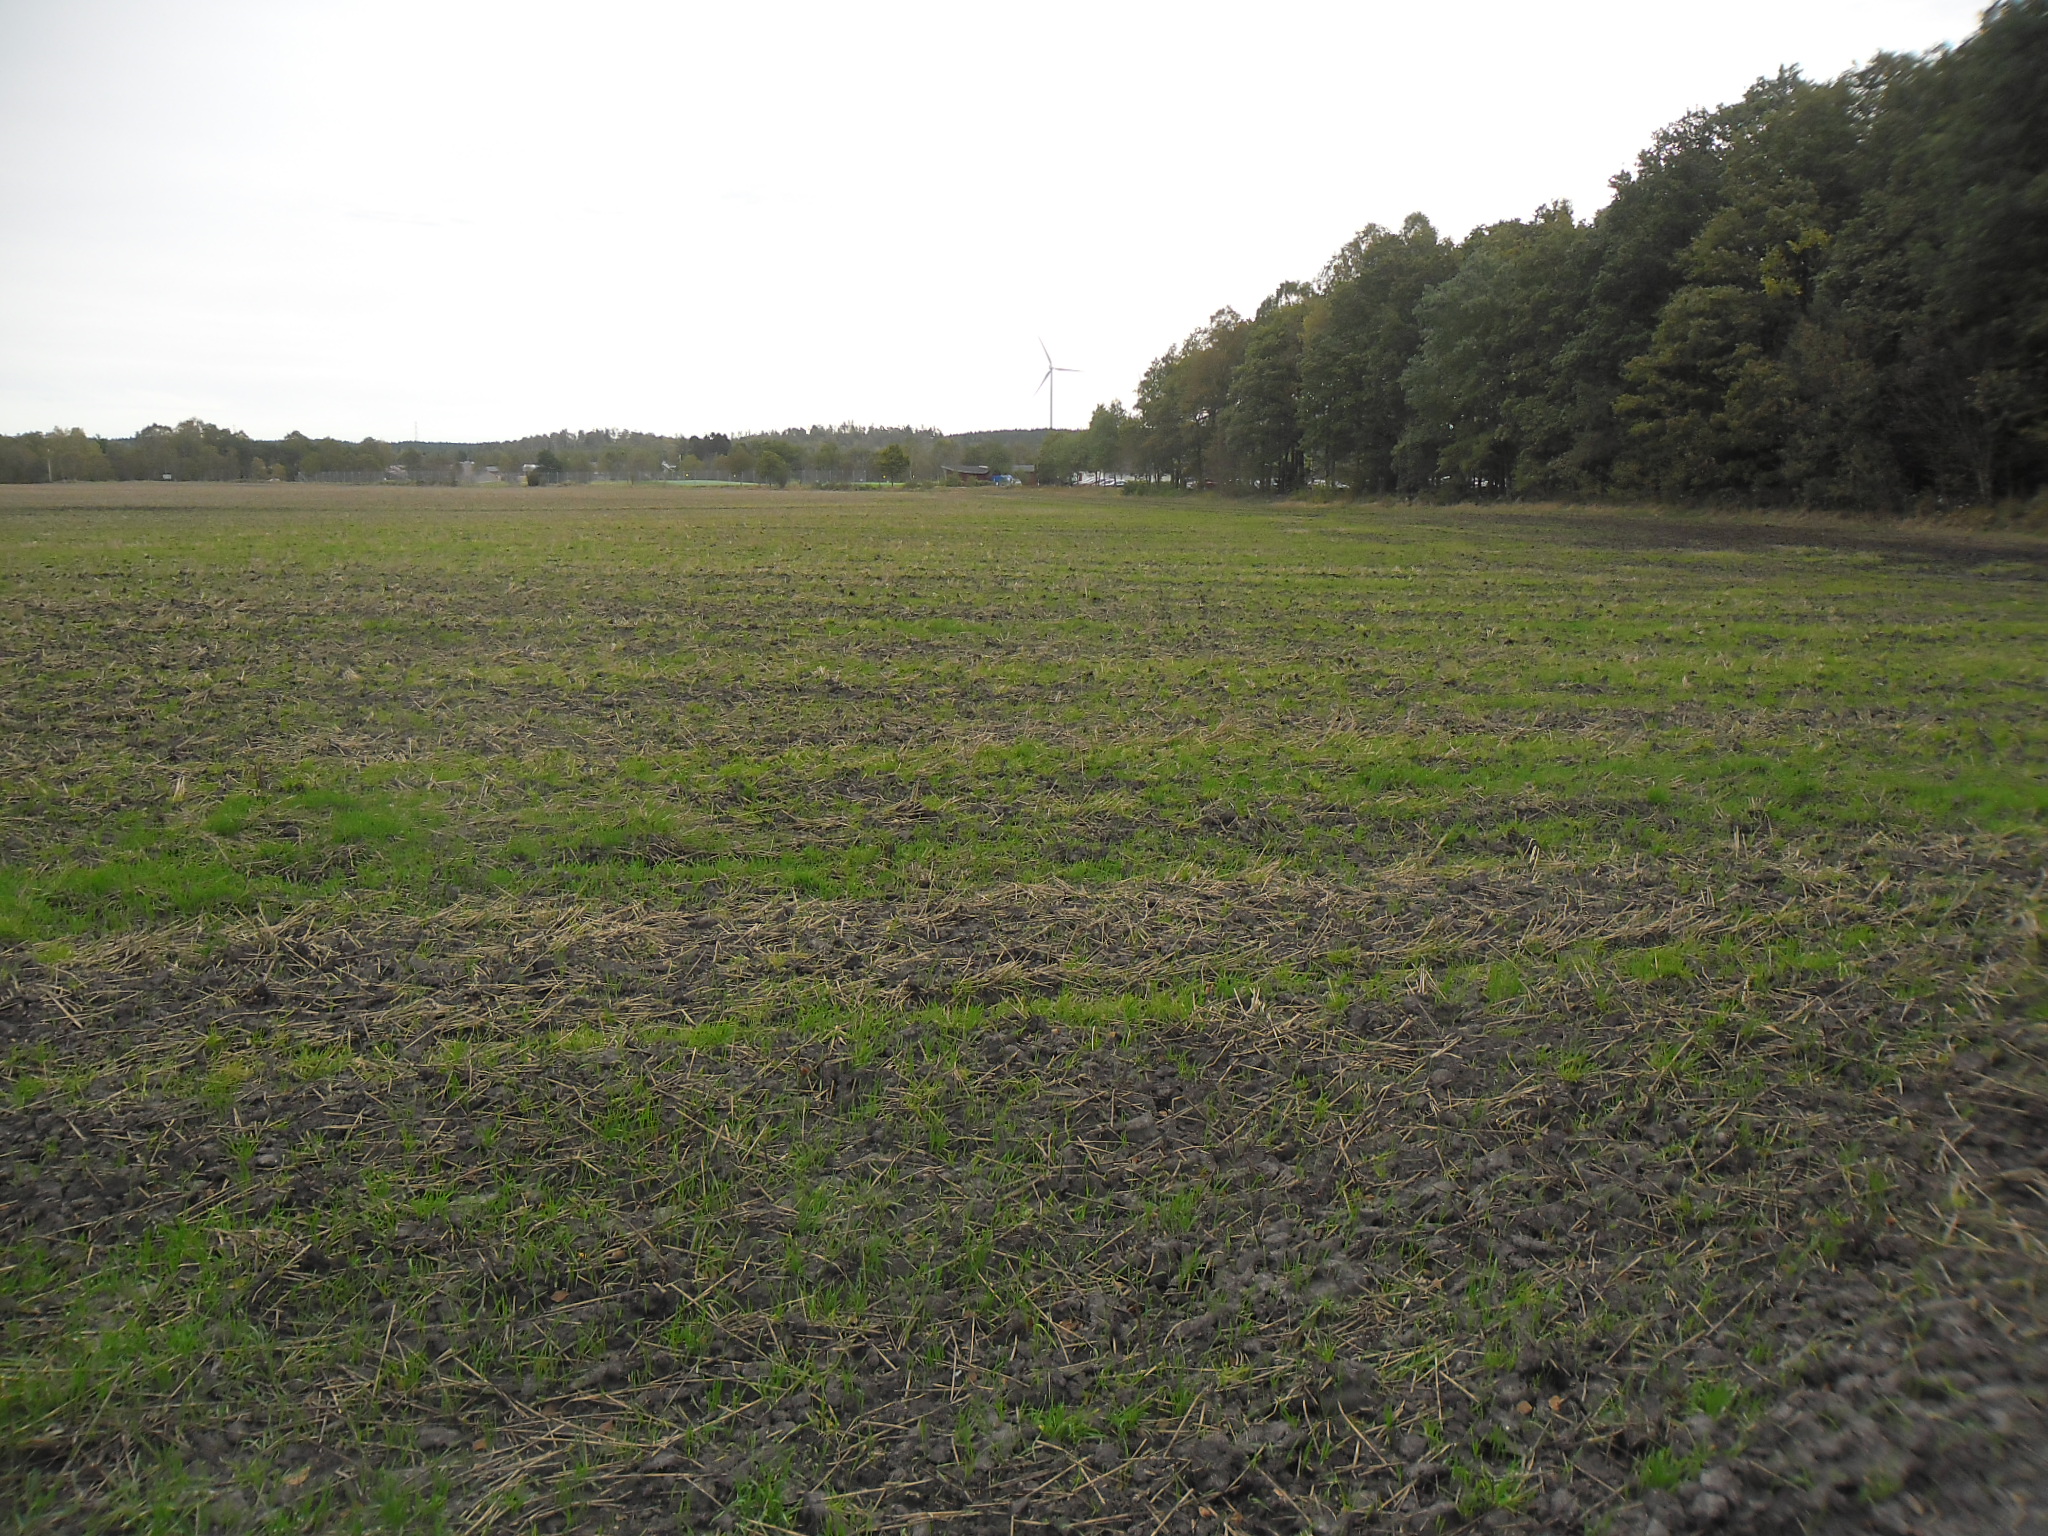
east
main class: Cropland
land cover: Common wheat
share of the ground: < 10 %
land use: Agriculture (excluding fallow land and kitchen gardens)
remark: Harvested field
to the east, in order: Common wheat; Lines of trees; Fences; Paved roads, cycling and walking lanes
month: October
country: SE
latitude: 56.5445
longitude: 13.1685
